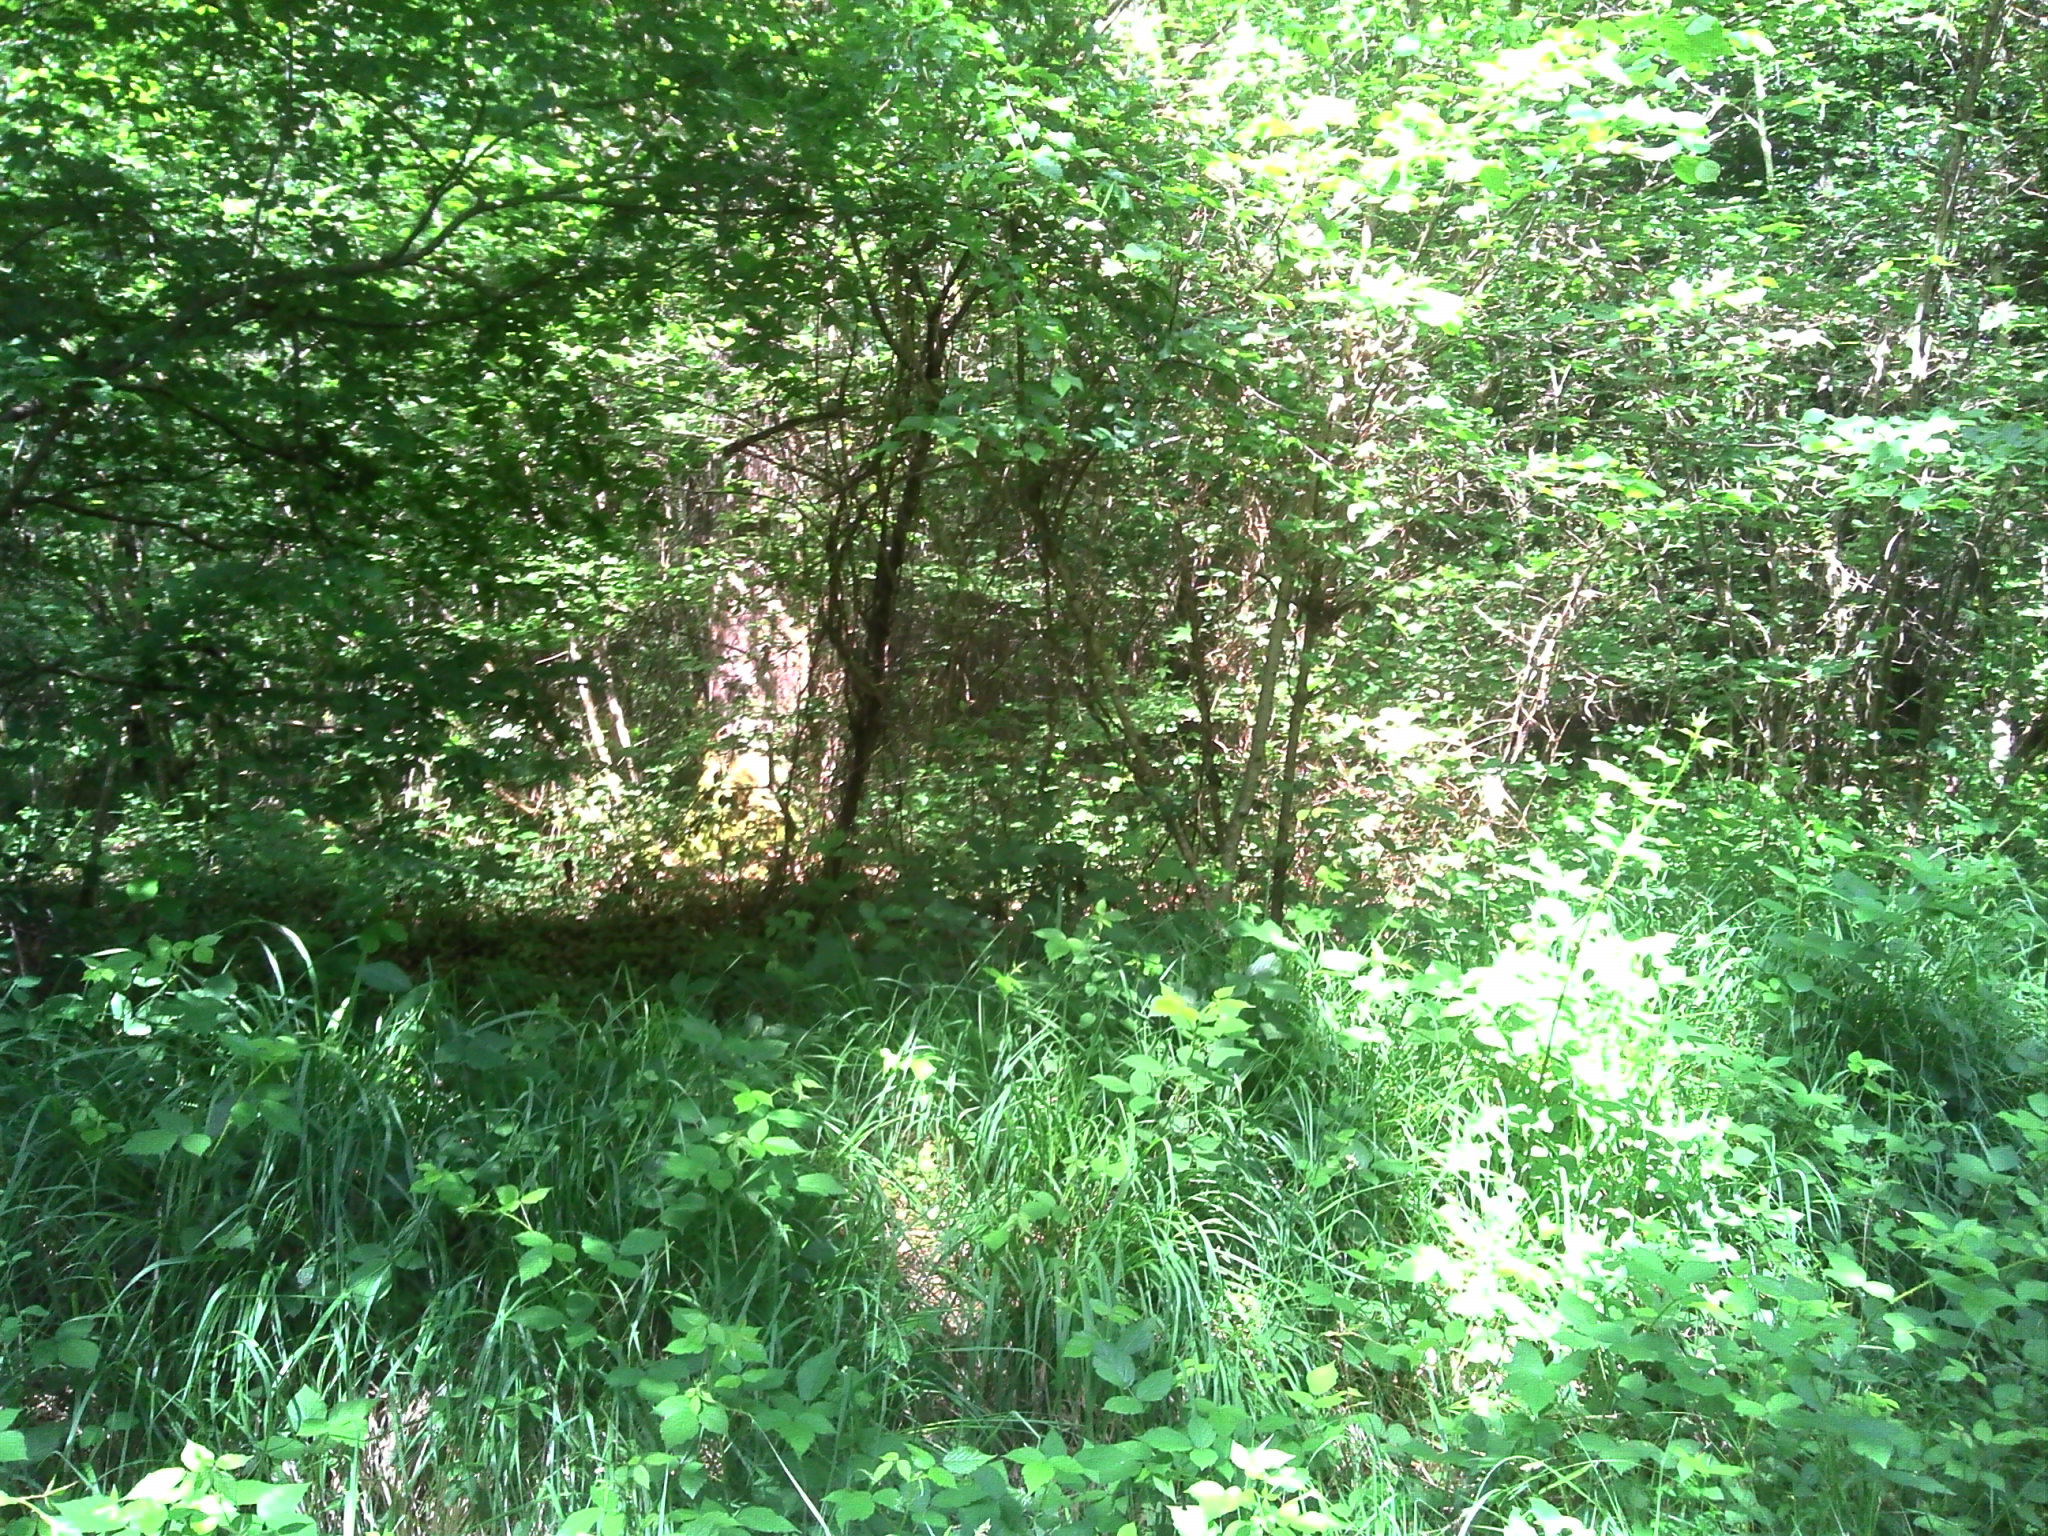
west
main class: Woodland
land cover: Broadleaved woodland
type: mesophytic deciduous forest
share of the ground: > 75 %
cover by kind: broadleaved forest trees 80 %, herbaceous plants 20 %
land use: Forestry
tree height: > 5 m
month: May
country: FR
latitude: 46.5654
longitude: 5.1360
